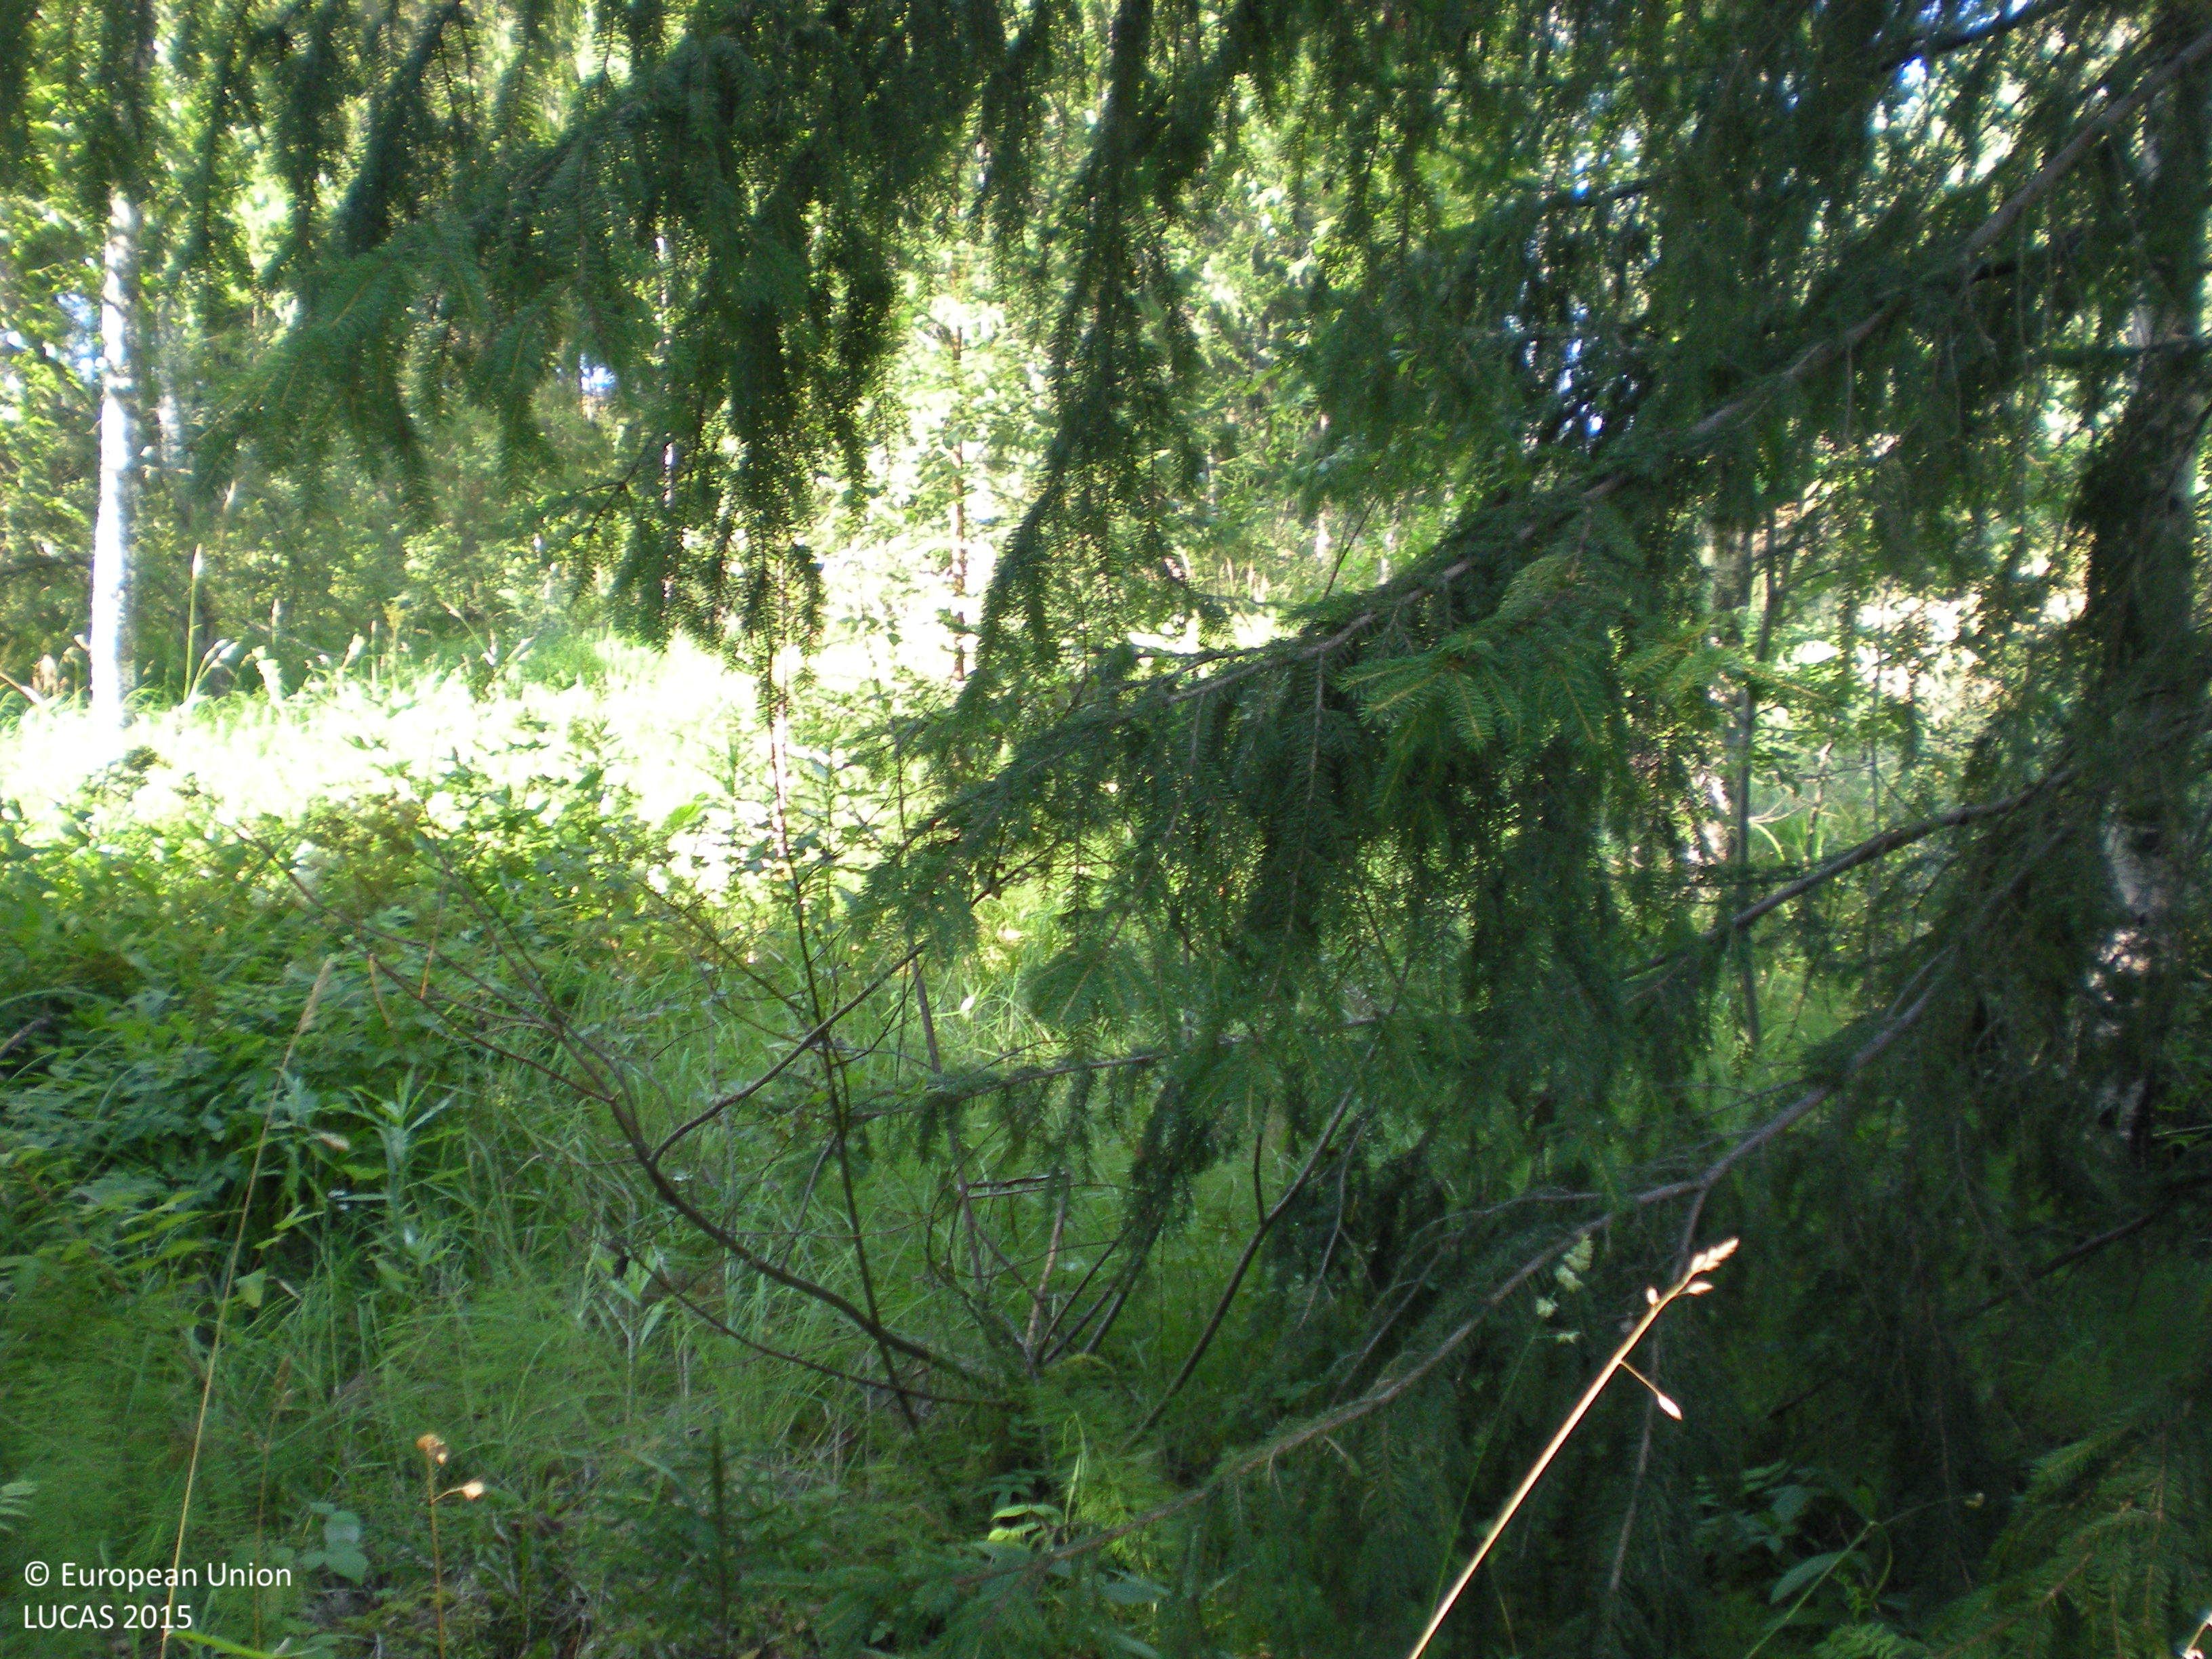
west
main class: Woodland
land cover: Spruce dominated mixed woodland
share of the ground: 50 - 75 %
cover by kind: broadleaved forest trees 35 %, herbaceous plants 30 %, coniferous forest trees 25 %, shrubs 10 %
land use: Forestry
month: August
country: SE
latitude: 60.6293
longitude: 16.8429
